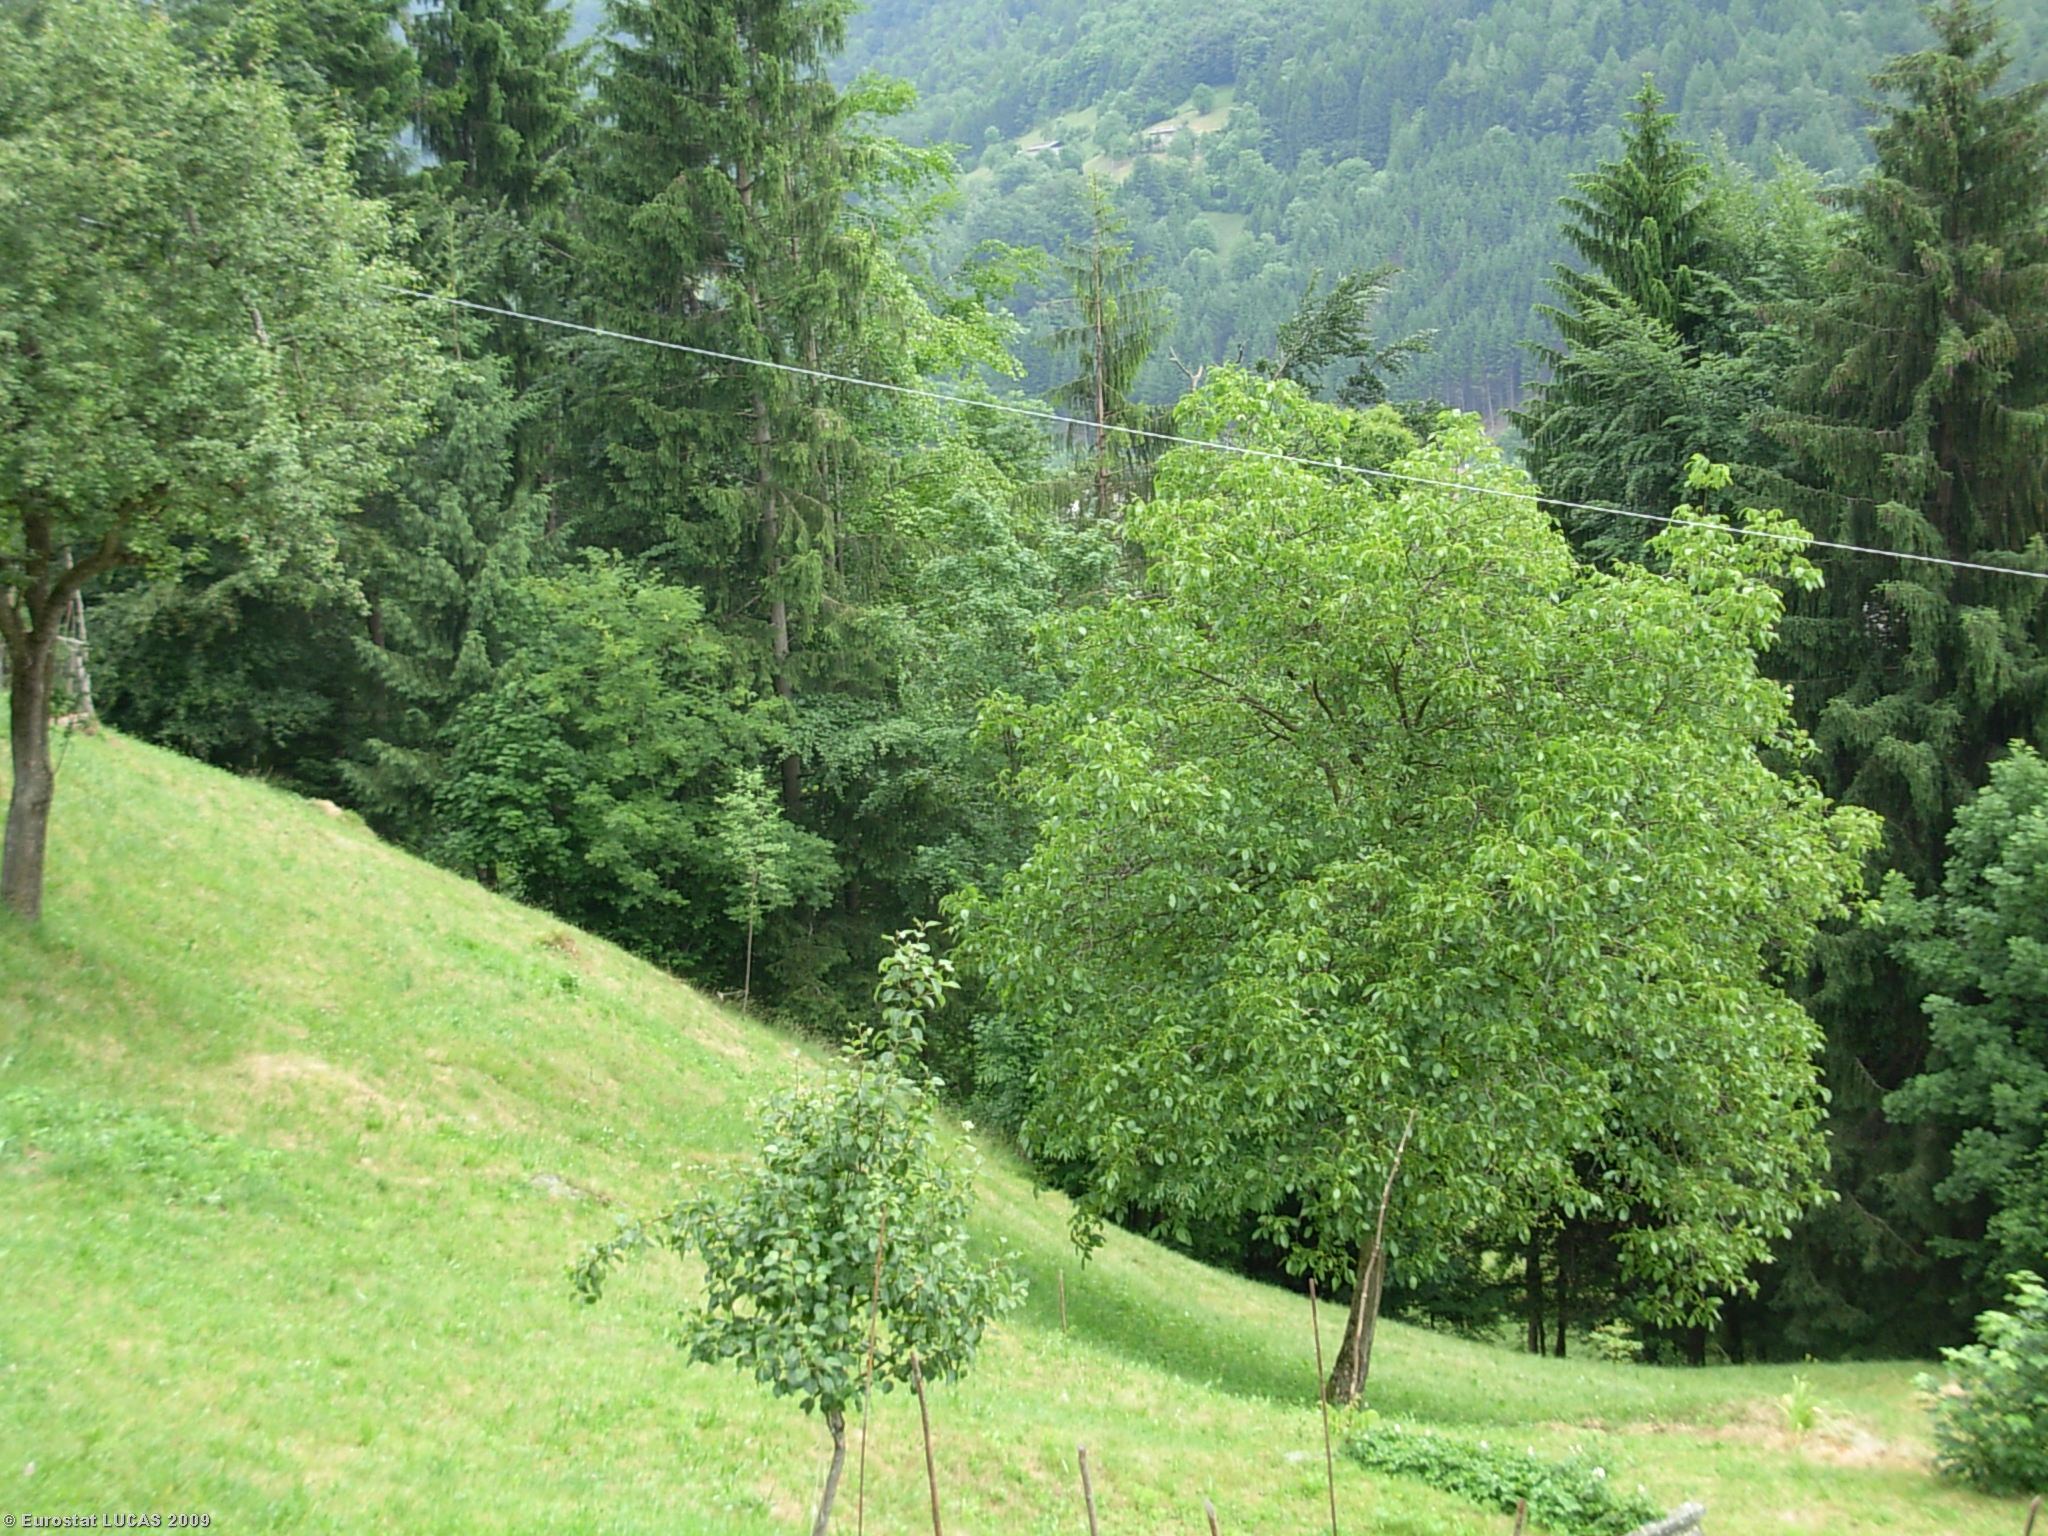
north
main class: Grassland
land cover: Grassland without tree/shrub cover
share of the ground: > 75 %
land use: Agriculture (excluding fallow land and kitchen gardens)
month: June
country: IT
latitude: 45.8278
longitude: 10.4498
